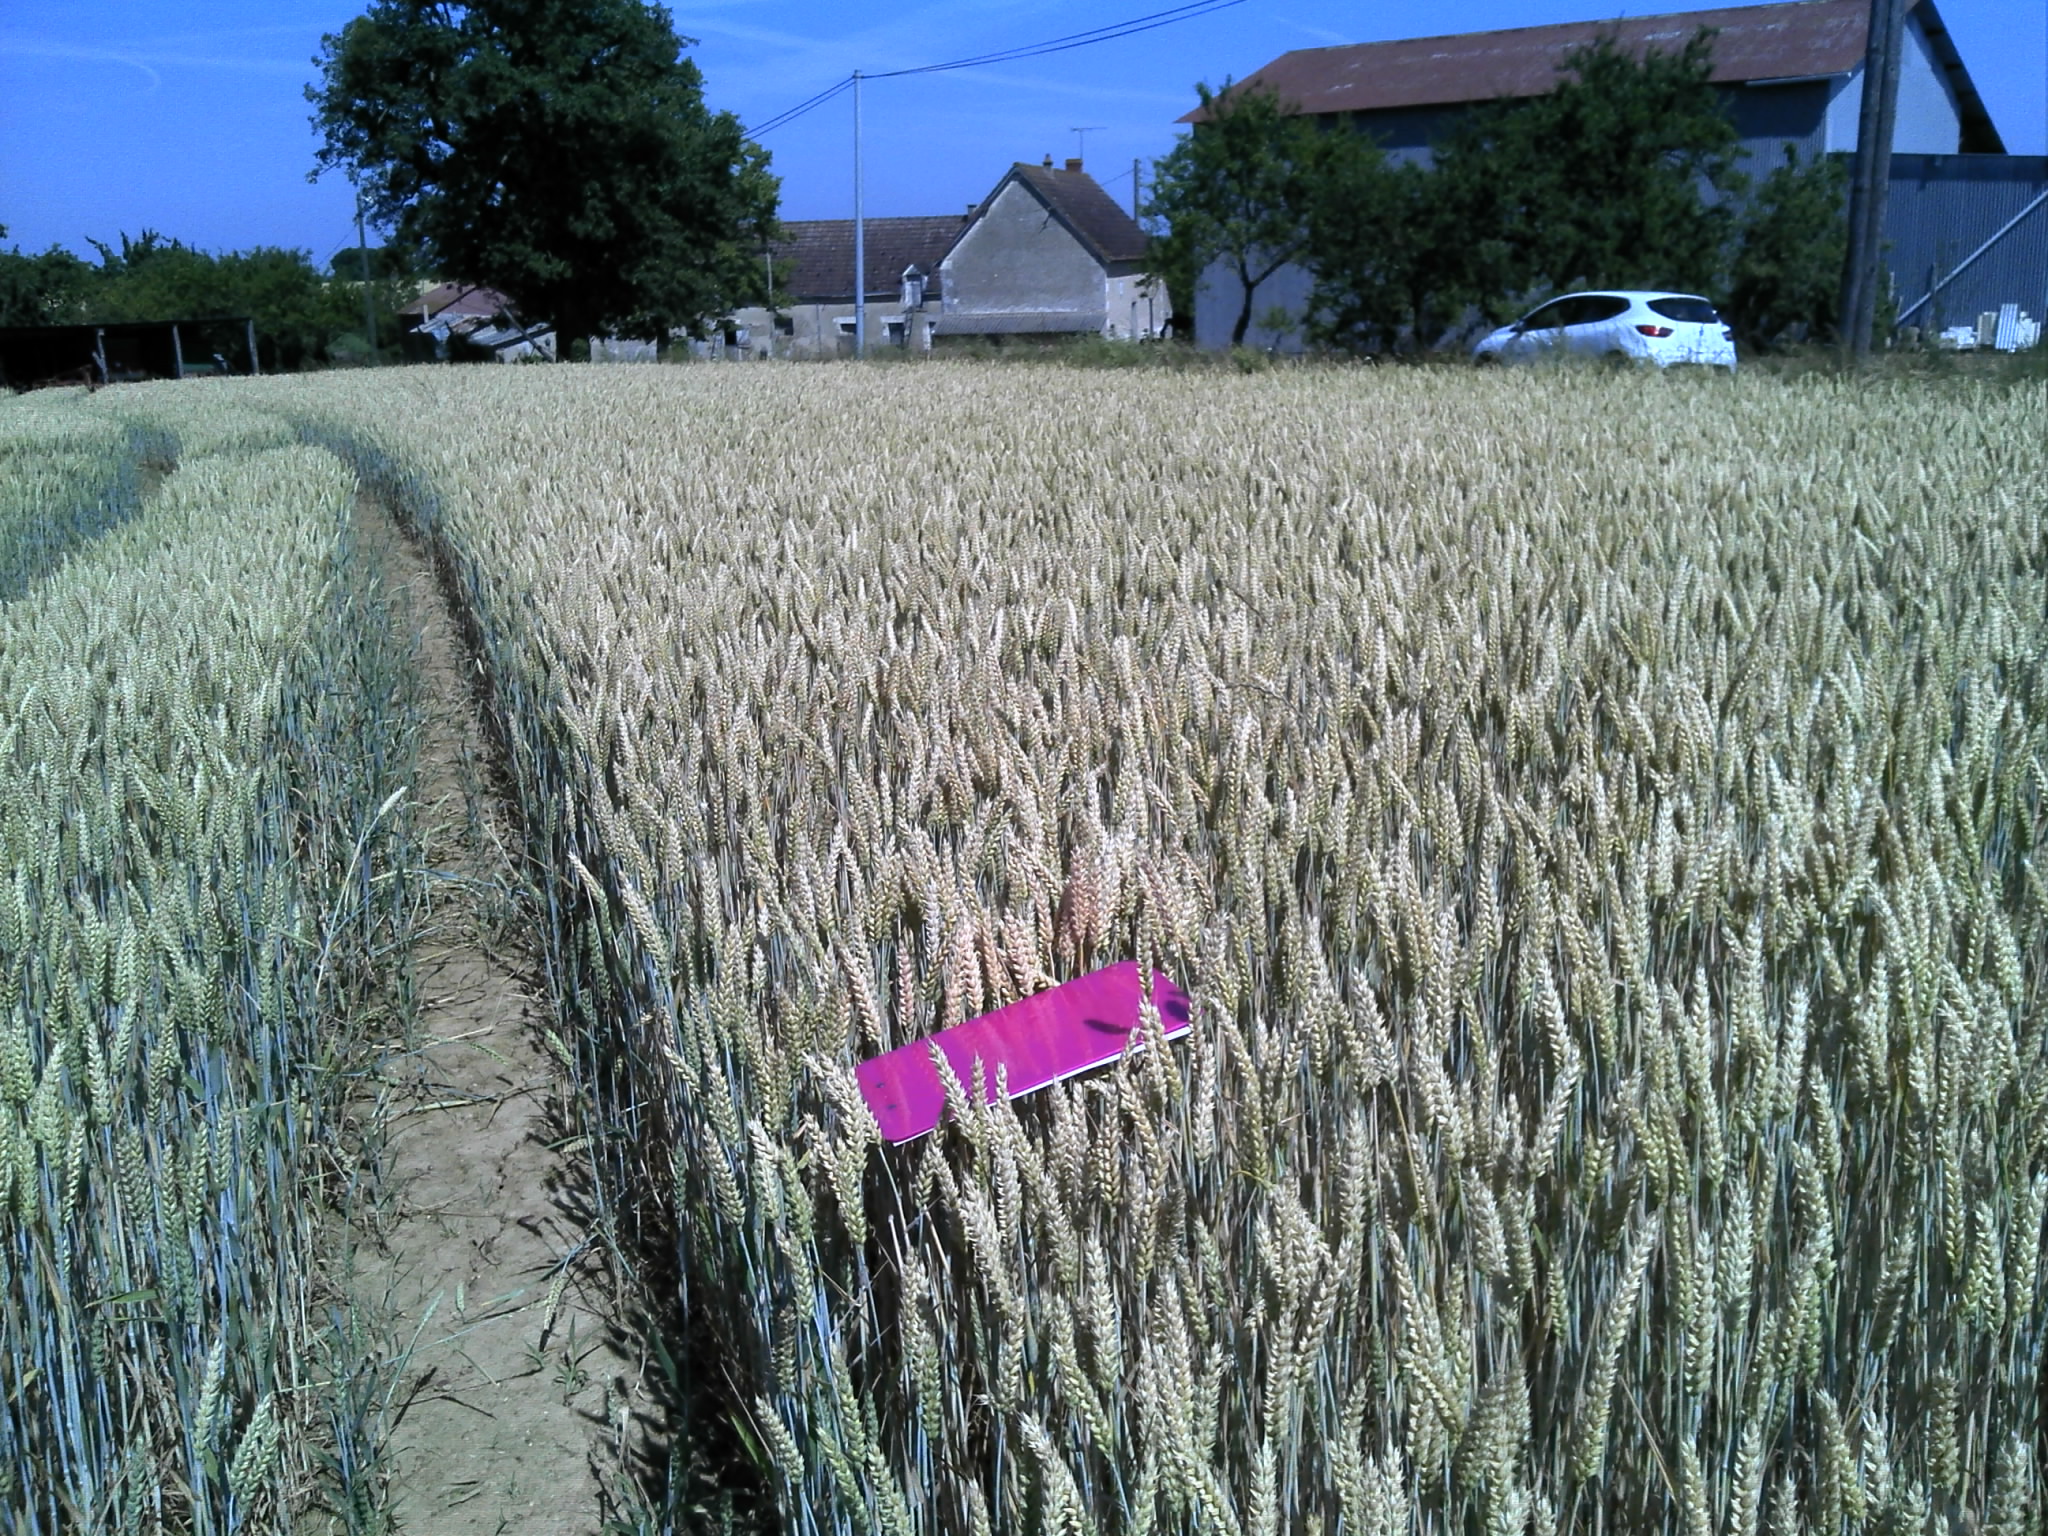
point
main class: Cropland
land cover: Common wheat
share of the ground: > 75 %
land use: Agriculture (excluding fallow land and kitchen gardens)
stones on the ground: < 10 %
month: June
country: FR
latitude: 47.1809
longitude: 1.3962
